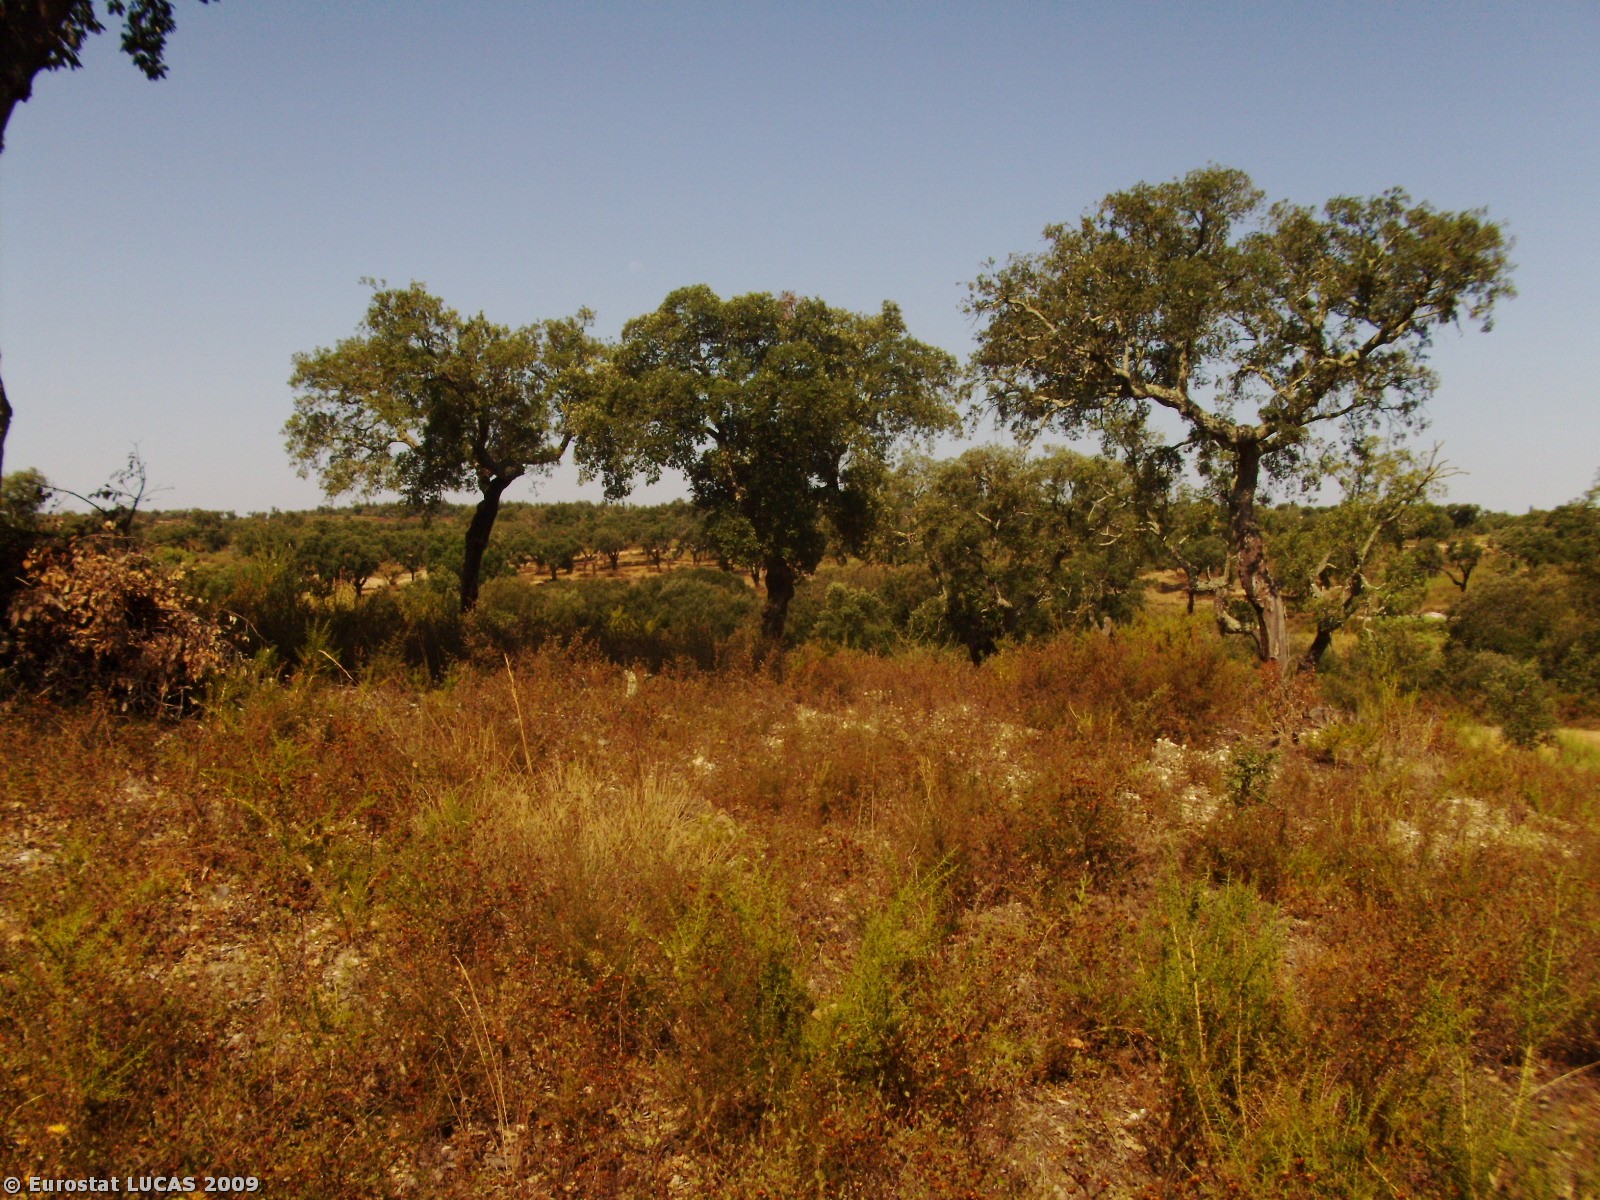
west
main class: Woodland
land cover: Broadleaved woodland
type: broadleaved evergreen forest
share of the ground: 25 - 50 %
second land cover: Spontaneously vegetated surfaces
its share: 25 - 50 %
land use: Forestry
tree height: > 5 m
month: August
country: PT
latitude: 39.2696
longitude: -8.1045
